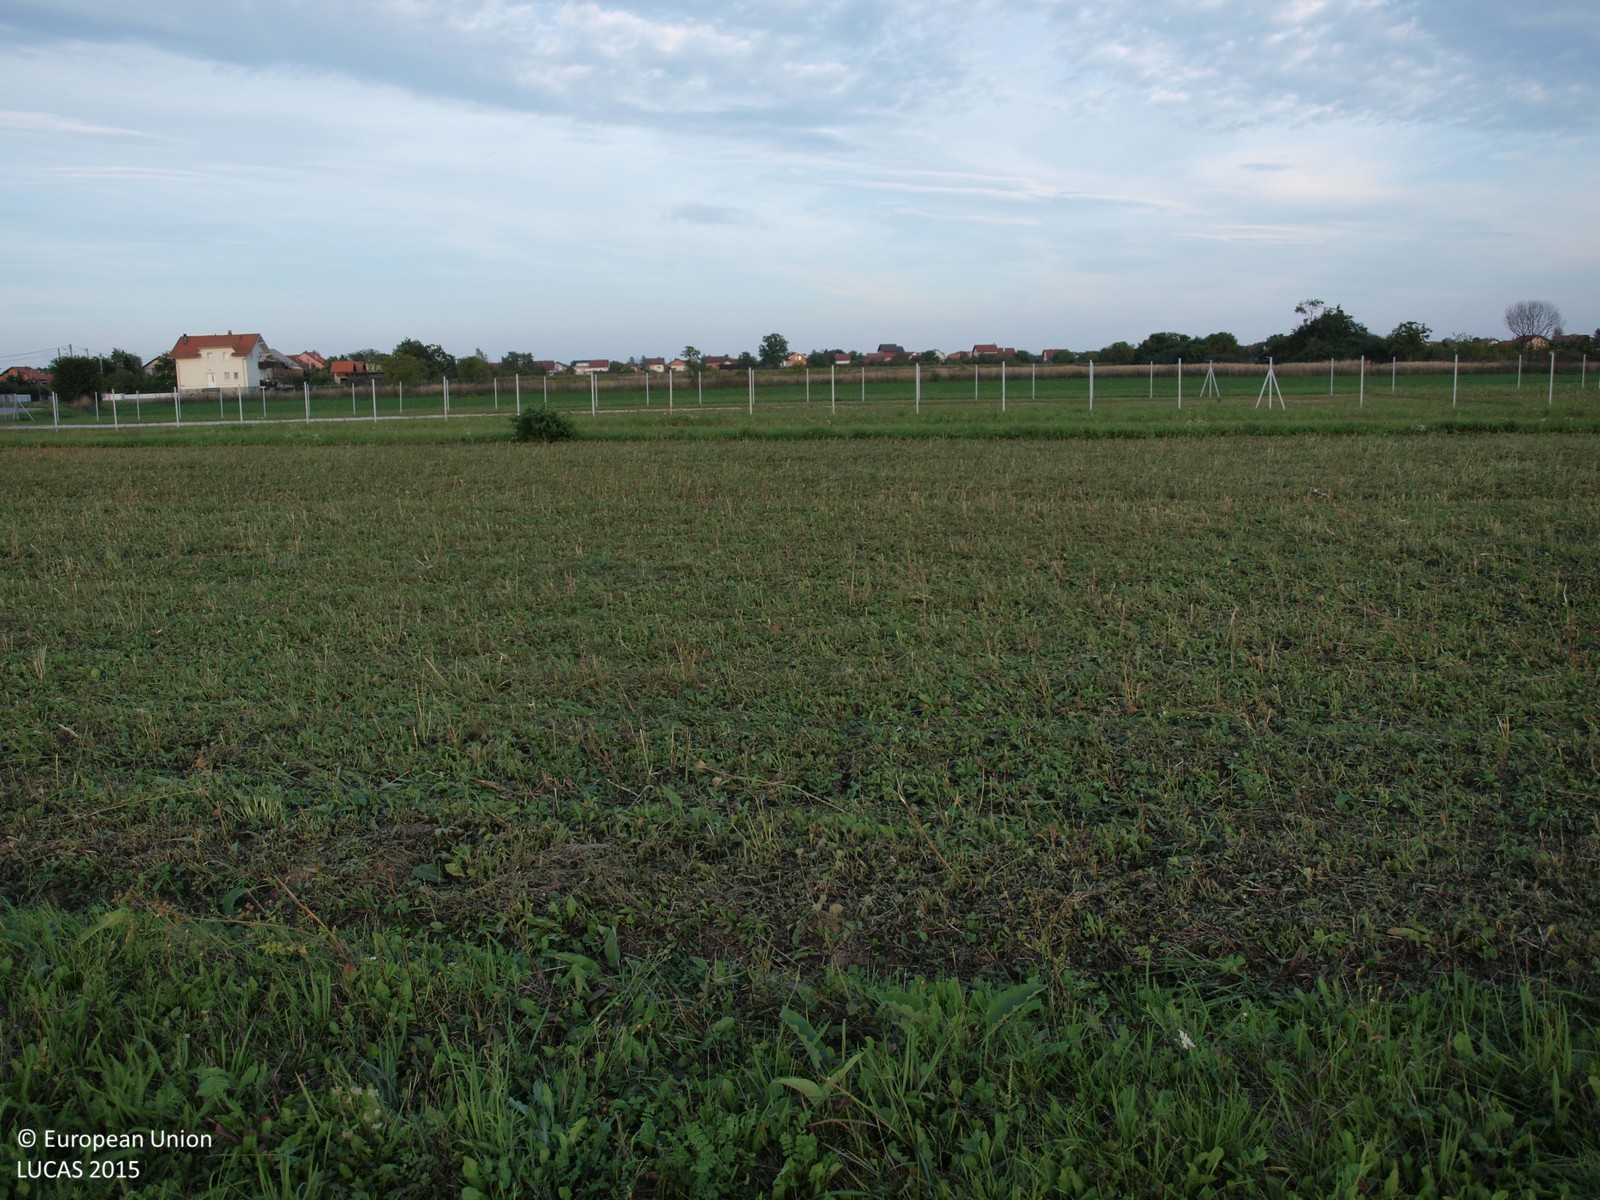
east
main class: Grassland
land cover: Grassland without tree/shrub cover
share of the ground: > 75 %
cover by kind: herbaceous plants 100 %
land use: Agriculture (excluding fallow land and kitchen gardens)
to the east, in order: Grassland without tree/shrub cover; Fences; Grassland without tree/shrub cover; Fences; Grassland without tree/shrub cover; Lucerne; Spontaneously vegetated surfaces; Tracks; Spontaneously vegetated surfaces
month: September
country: HR
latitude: 45.7269
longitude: 16.0756
